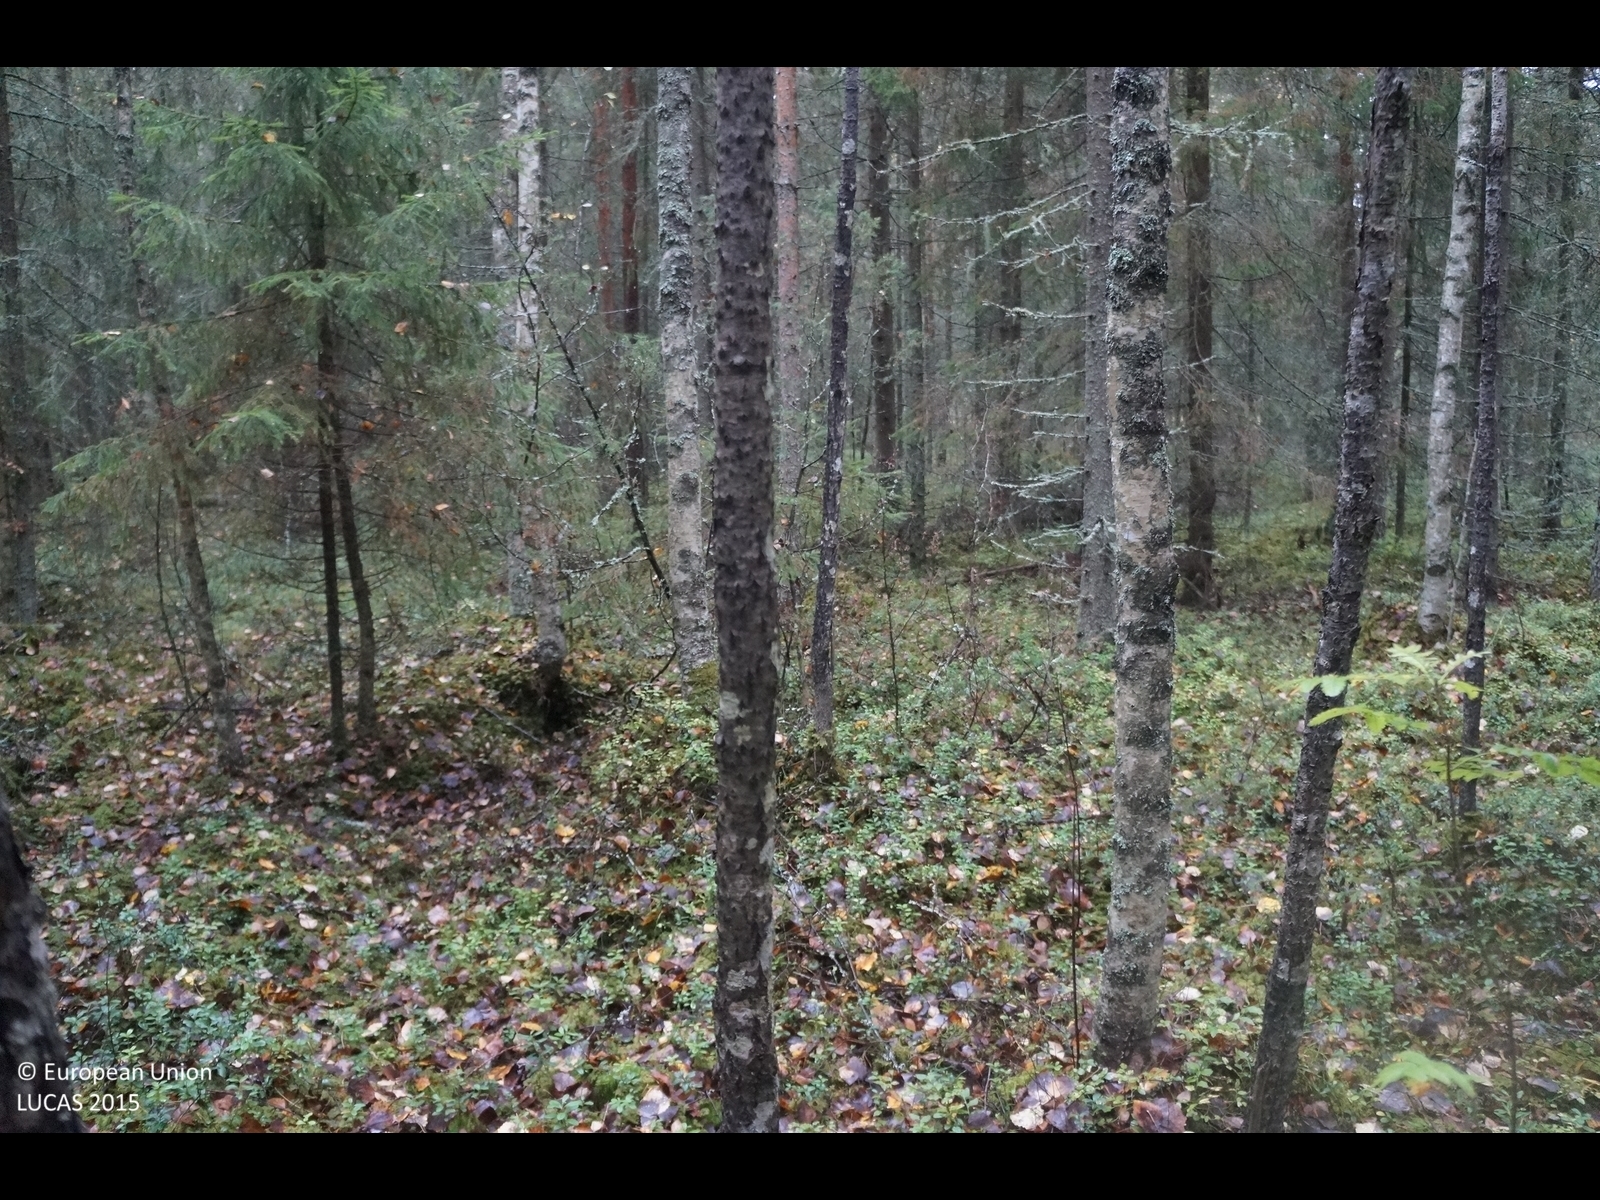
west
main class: Woodland
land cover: Spruce dominated mixed woodland
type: boreal forest
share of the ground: 50 - 75 %
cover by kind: coniferous forest trees 50 %, broadleaved forest trees 20 %, shrubs 15 %, lichens and mosses 15 %
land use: Forestry
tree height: > 5 m
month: September
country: FI
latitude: 64.1213
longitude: 24.4258
